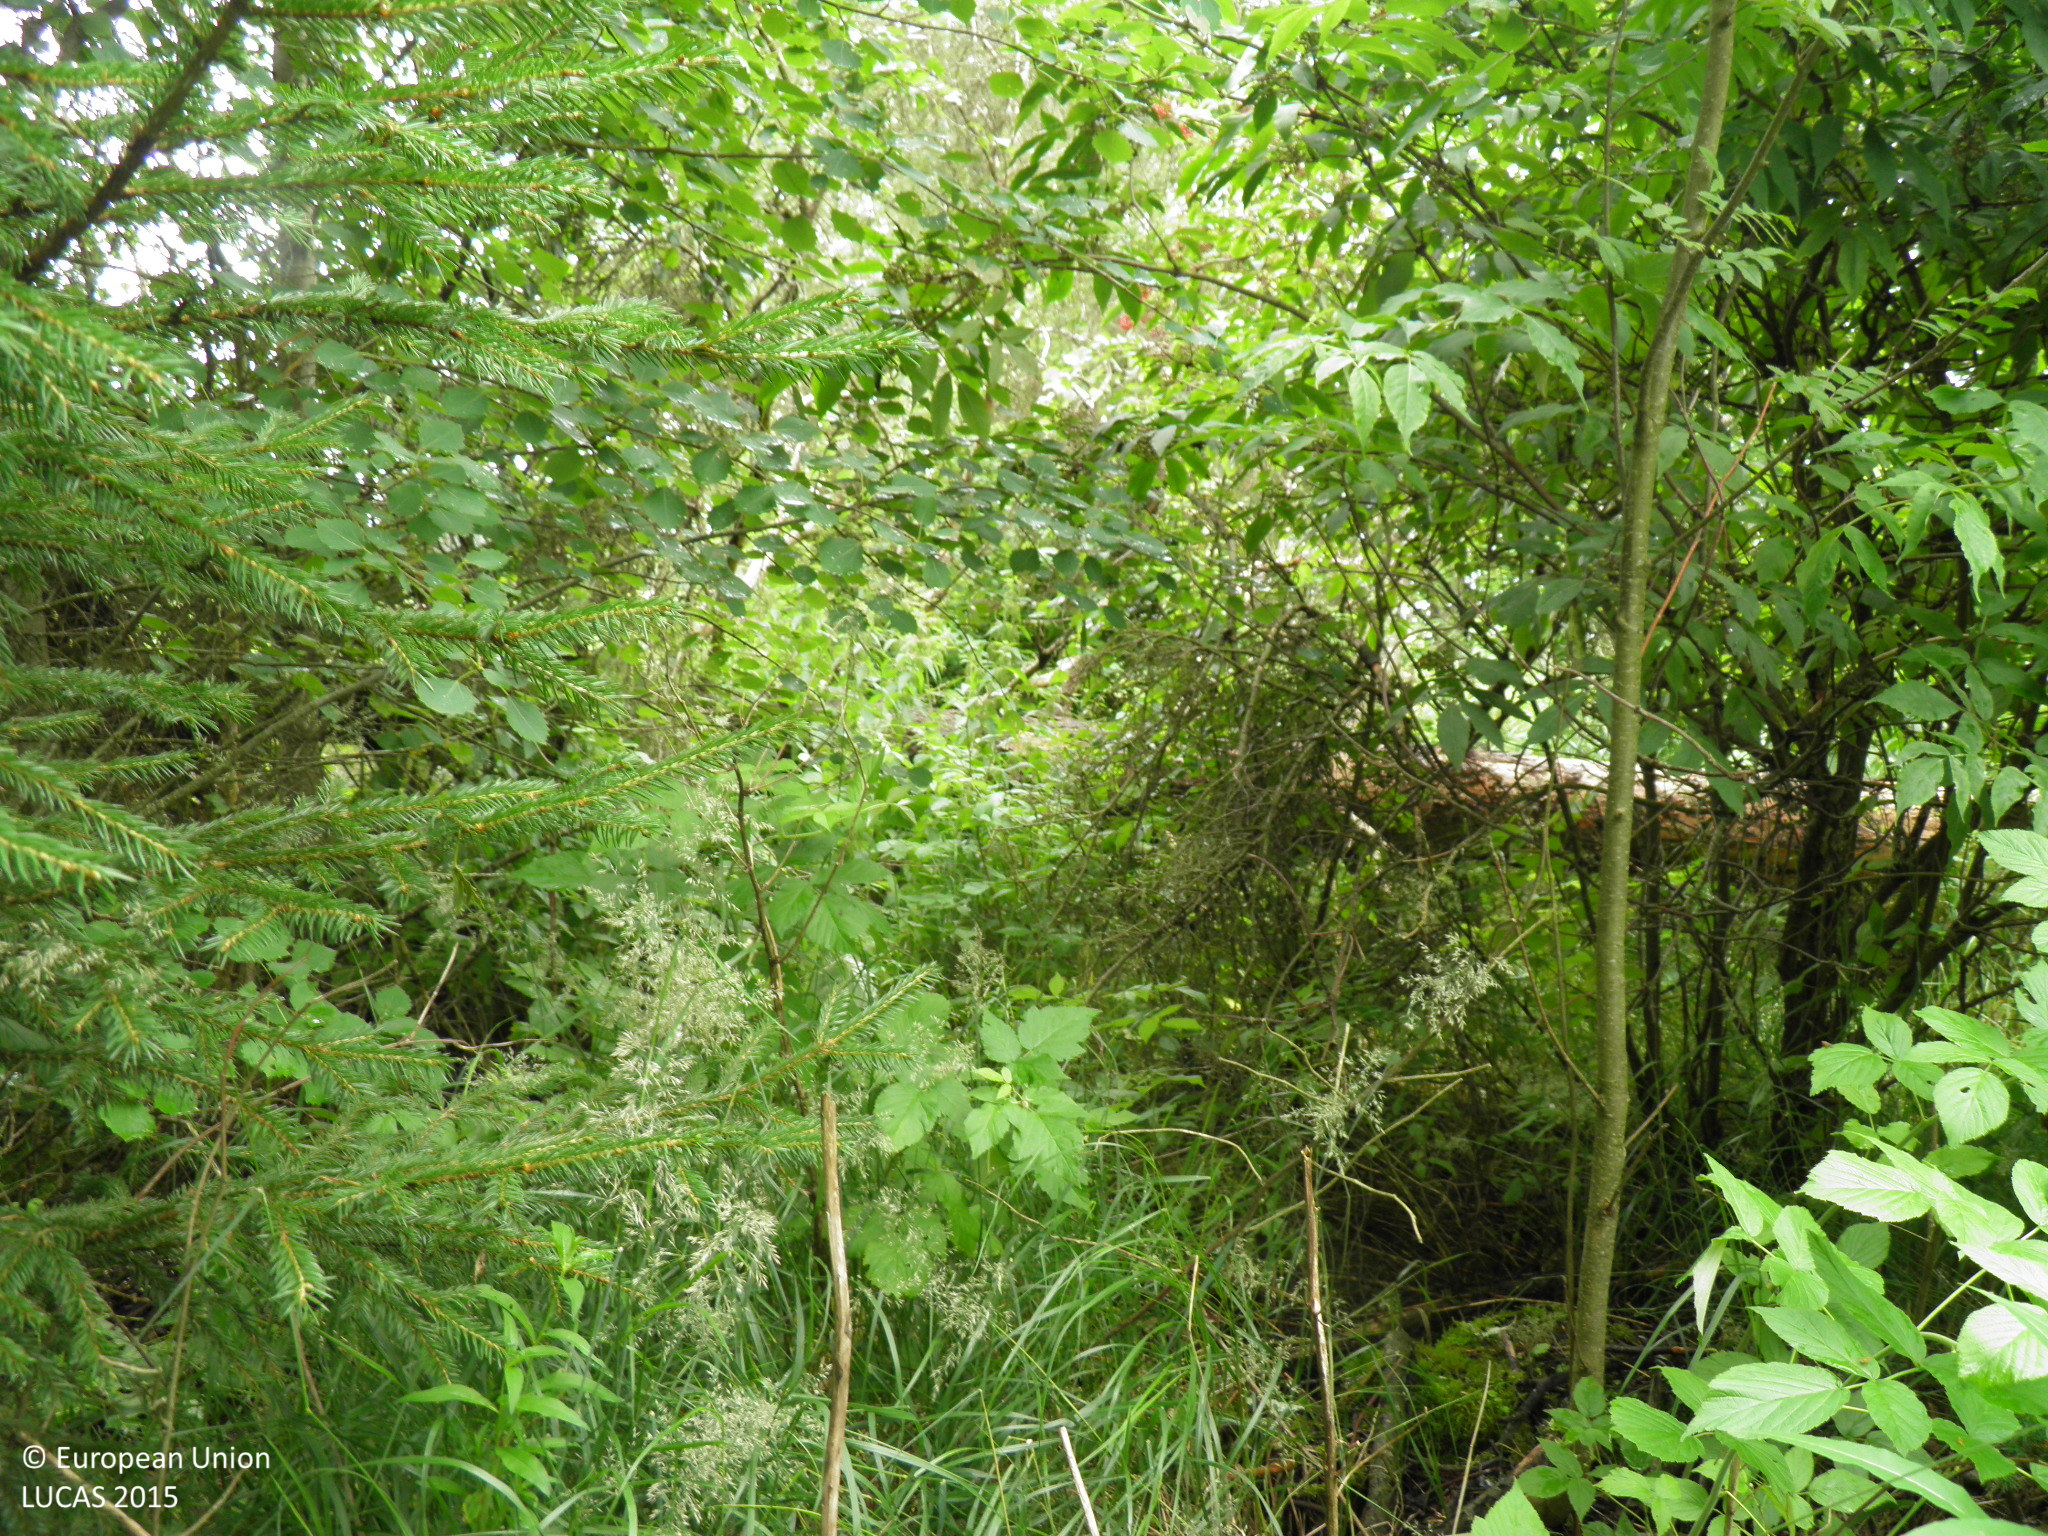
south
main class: Woodland
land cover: Spruce dominated mixed woodland
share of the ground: 50 - 75 %
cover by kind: broadleaved forest trees 40 %, coniferous forest trees 25 %, shrubs 20 %, herbaceous plants 15 %
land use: Forestry
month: July
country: FI
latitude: 60.8917
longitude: 22.8062
